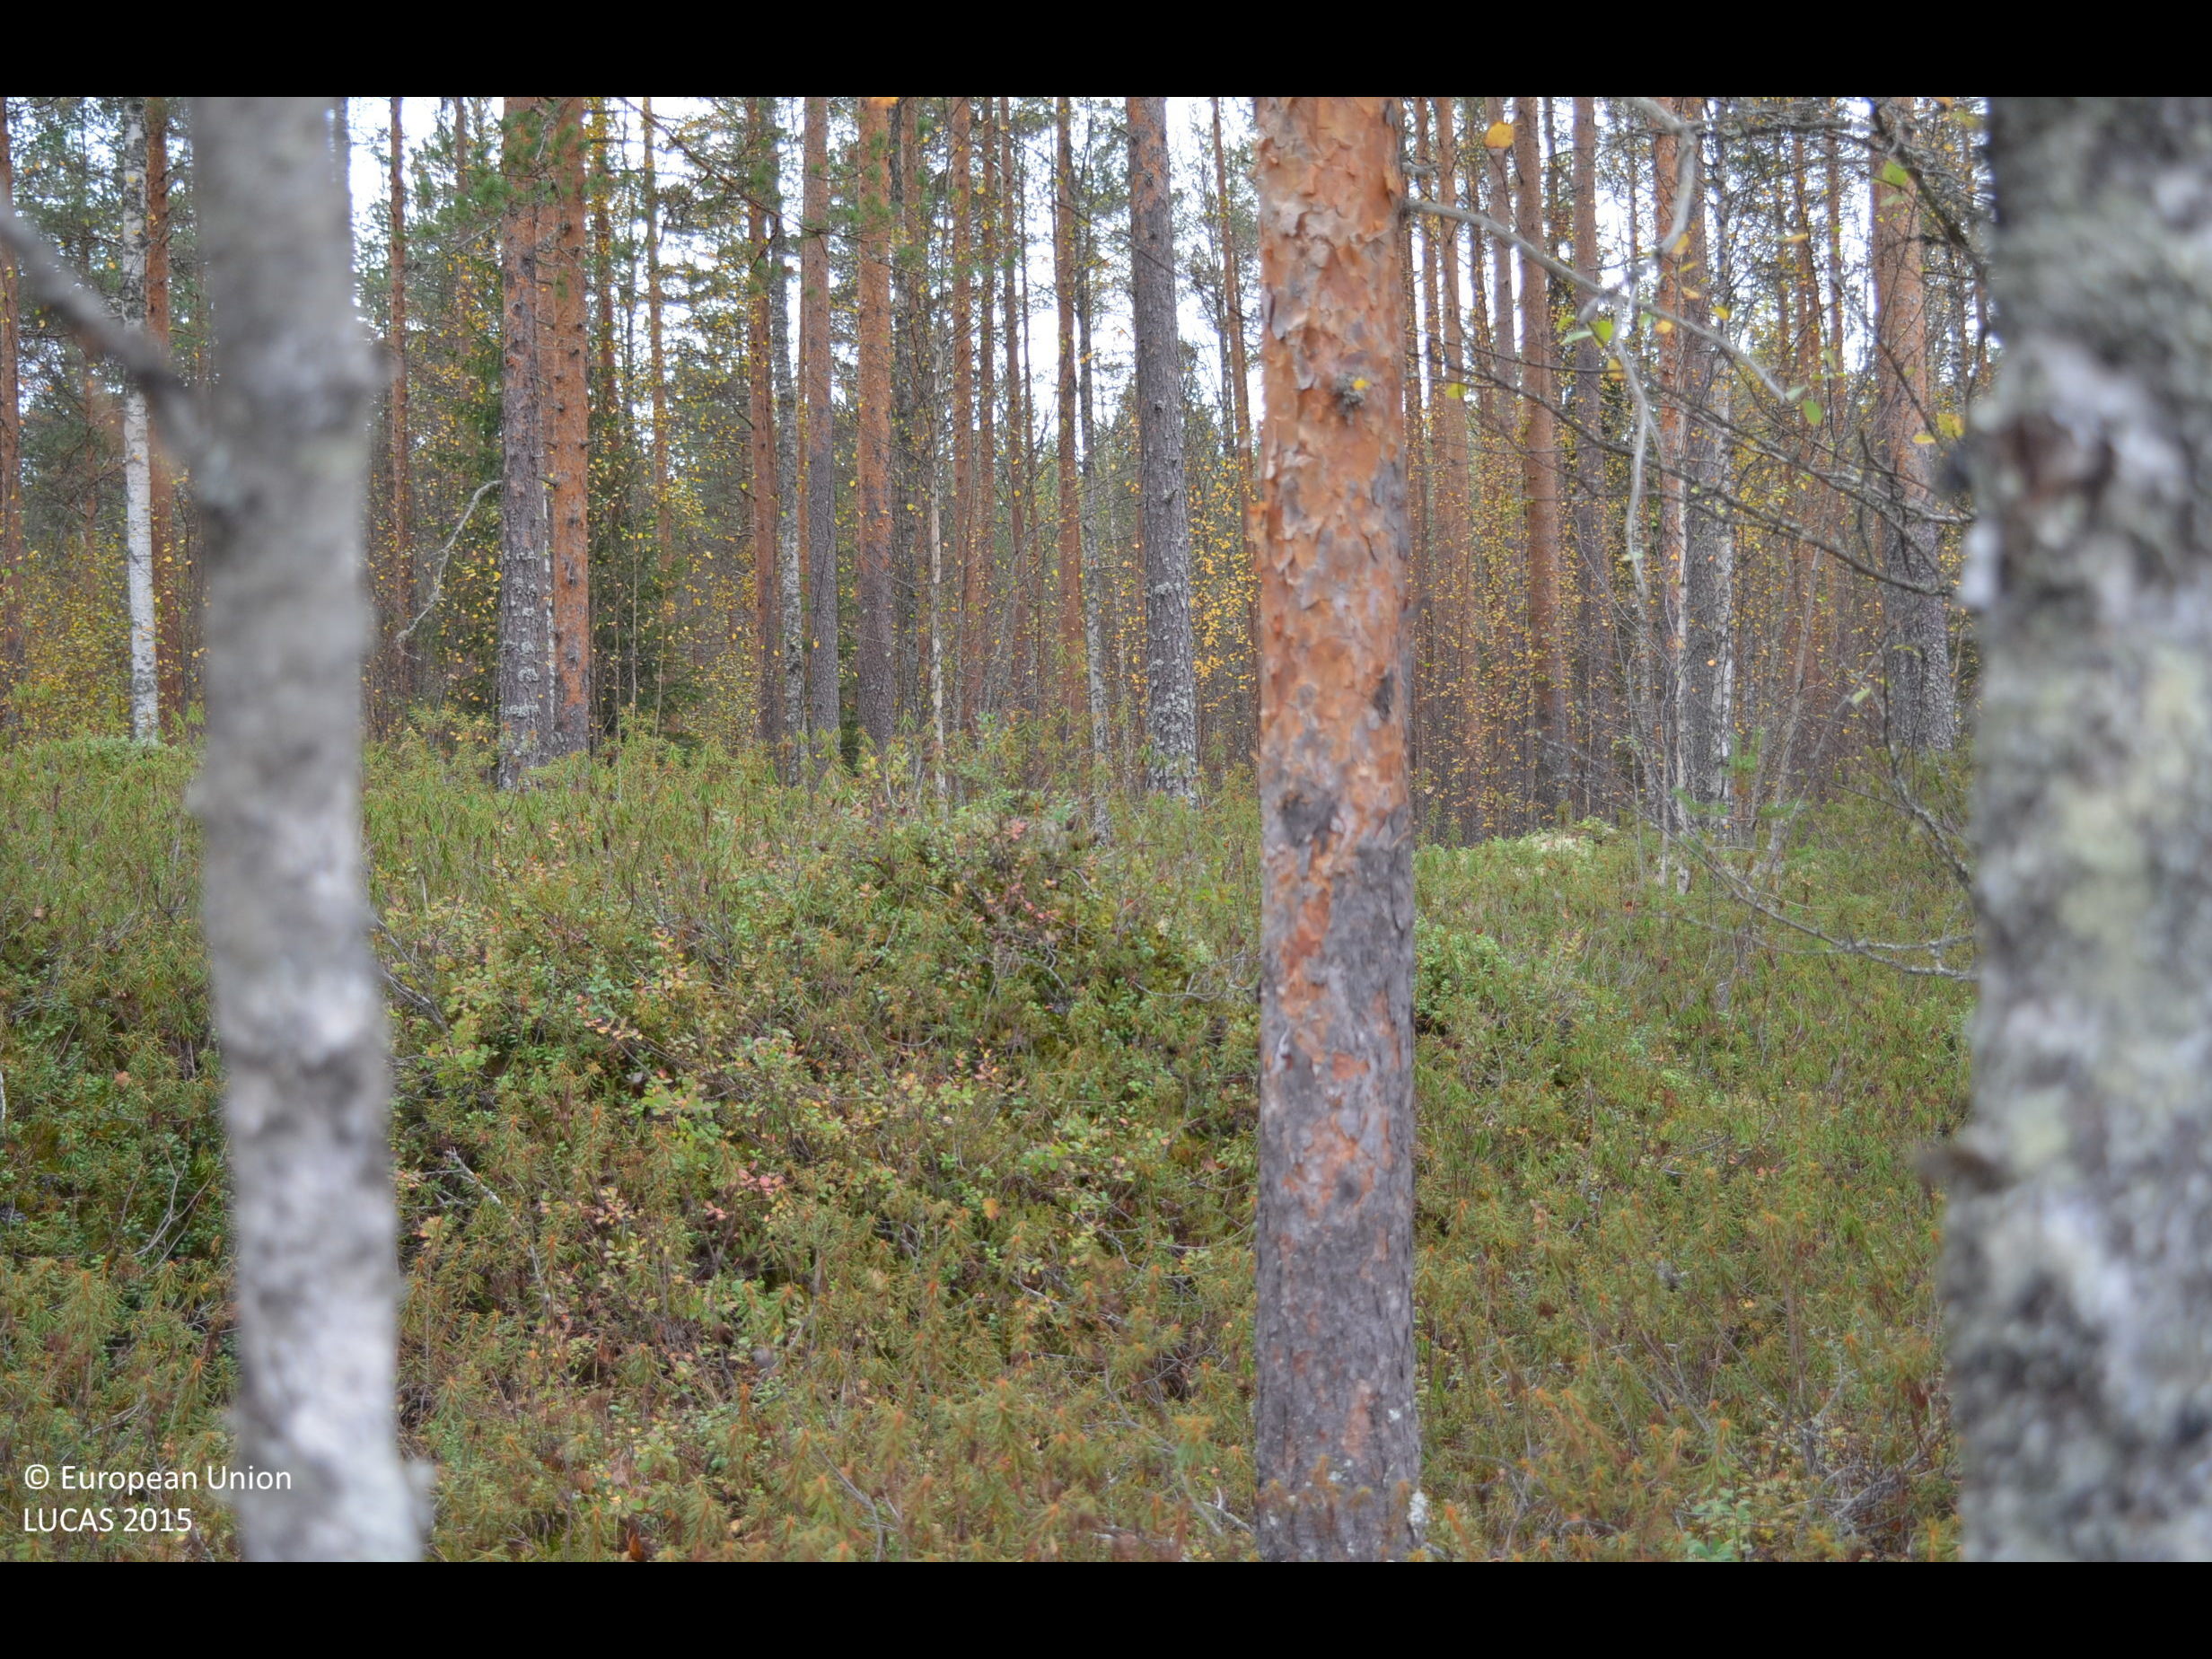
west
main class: Woodland
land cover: Pine dominated mixed woodland
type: boreal forest
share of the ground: 50 - 75 %
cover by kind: coniferous forest trees 50 %, shrubs 25 %, broadleaved forest trees 20 %, lichens and mosses 5 %
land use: Forestry
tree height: > 5 m
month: September
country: FI
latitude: 62.4308
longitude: 23.6116
